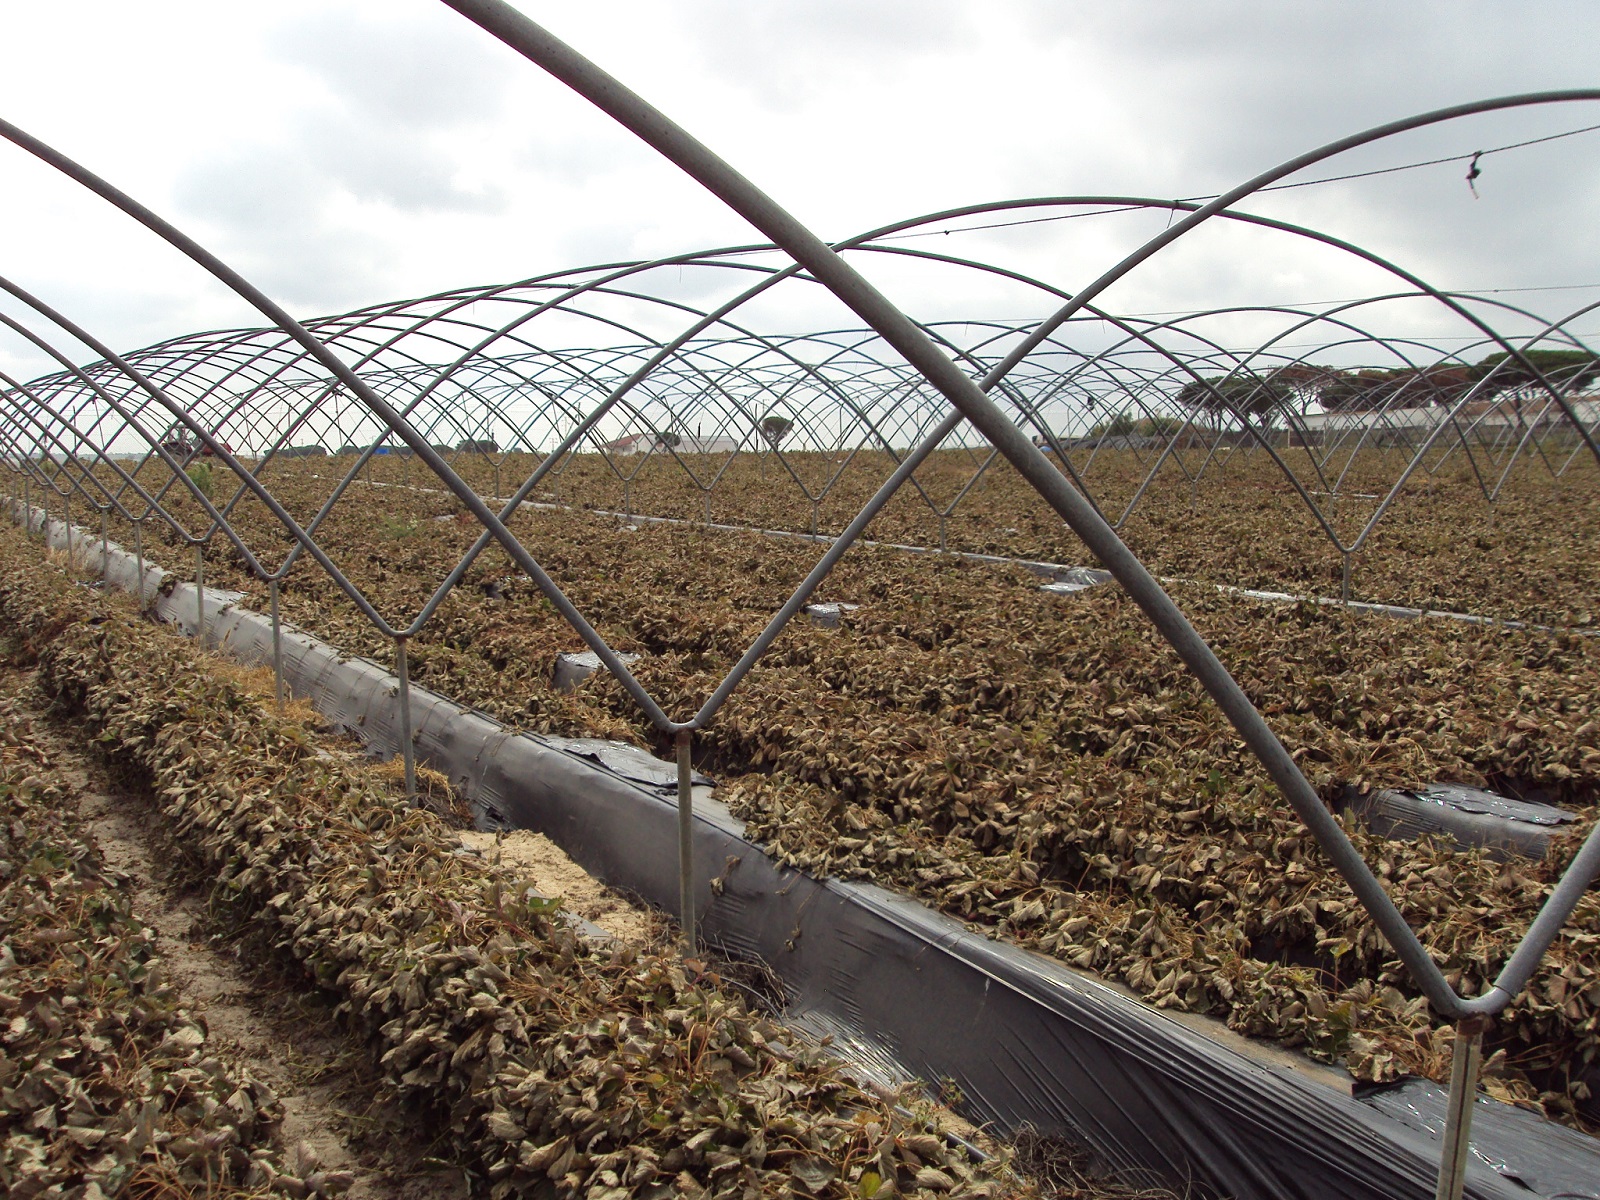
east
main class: Artificial land
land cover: Greenhouses
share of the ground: > 75 %
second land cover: Strawberries
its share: > 75 %
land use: Agriculture (excluding fallow land and kitchen gardens)
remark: Harvested field
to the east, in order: Artificial constructions in urban areas; Strawberries; Tracks; Fences; Grass margins; Other bare soil
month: June
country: ES
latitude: 37.1743
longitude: -6.8499
